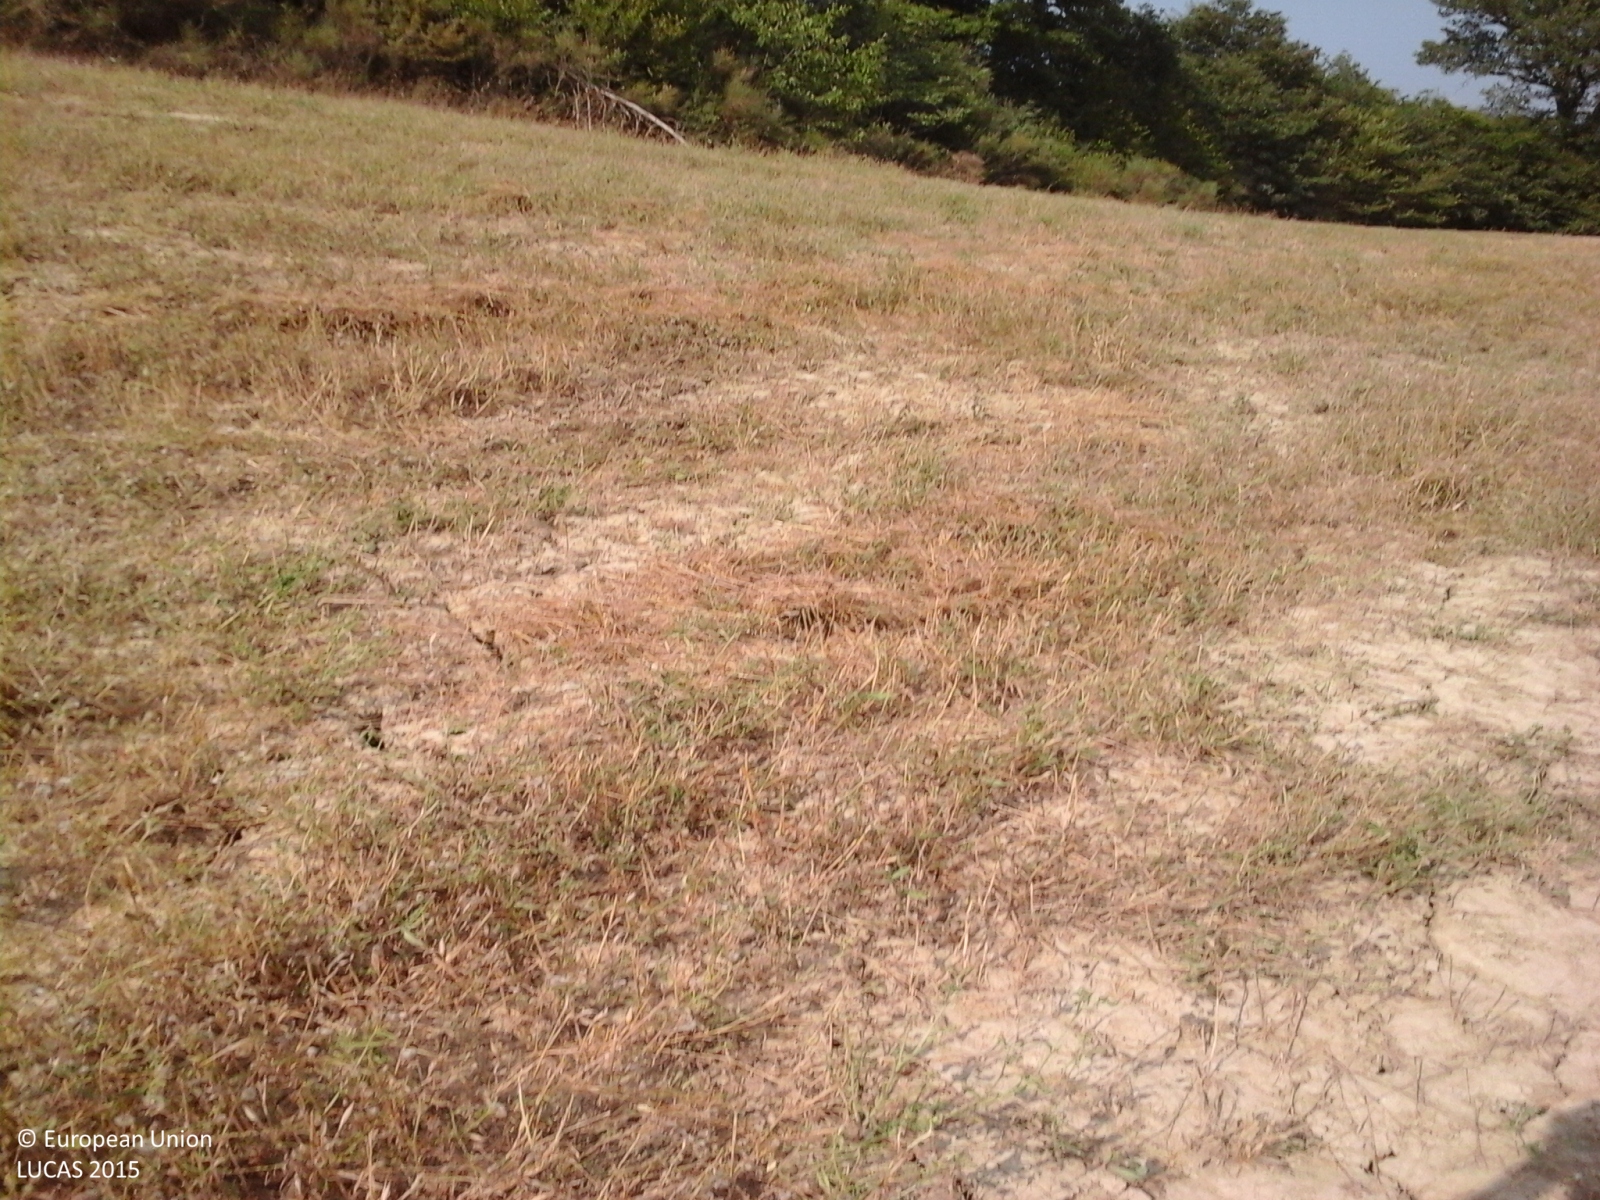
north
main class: Cropland
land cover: Mixed cereals for fodder
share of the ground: > 75 %
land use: Agriculture (excluding fallow land and kitchen gardens)
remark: Harvested field
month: July
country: IT
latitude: 43.1474
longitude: 11.5815
